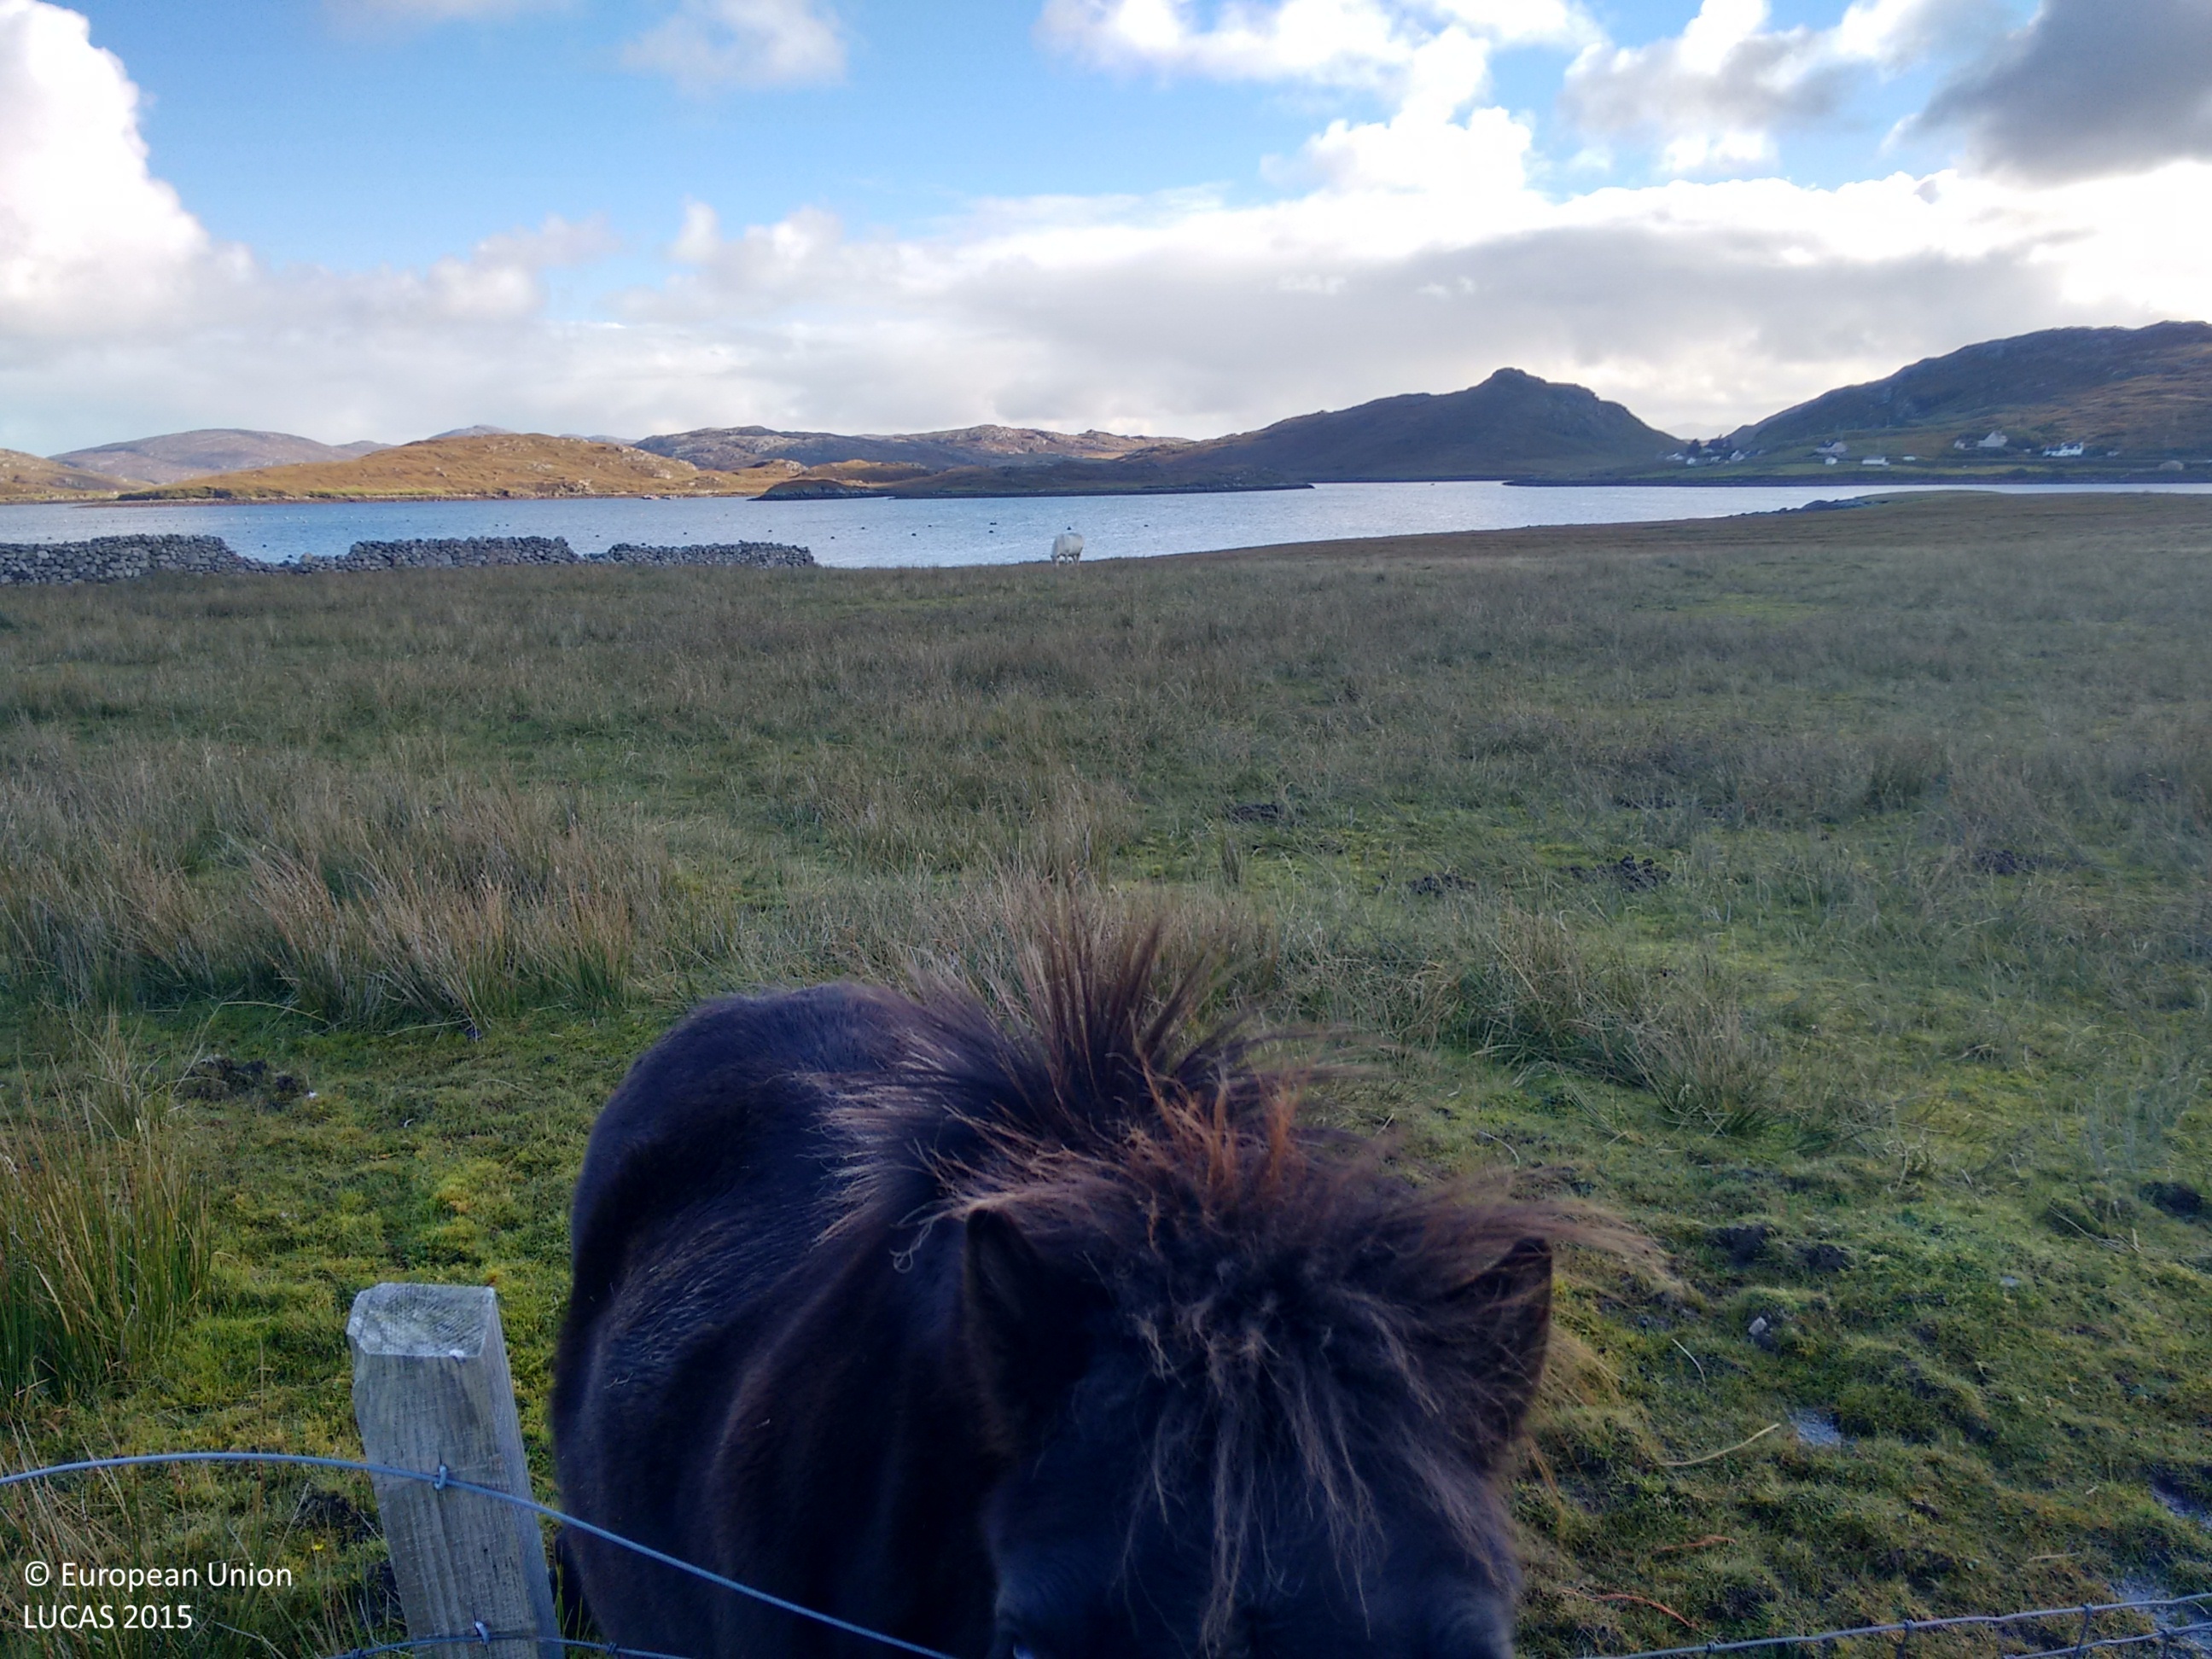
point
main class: Grassland
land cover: Grassland without tree/shrub cover
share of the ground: > 75 %
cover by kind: herbaceous plants 100 %
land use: Agriculture (excluding fallow land and kitchen gardens)
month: October
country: GB
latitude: 58.2012
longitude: -6.9452
